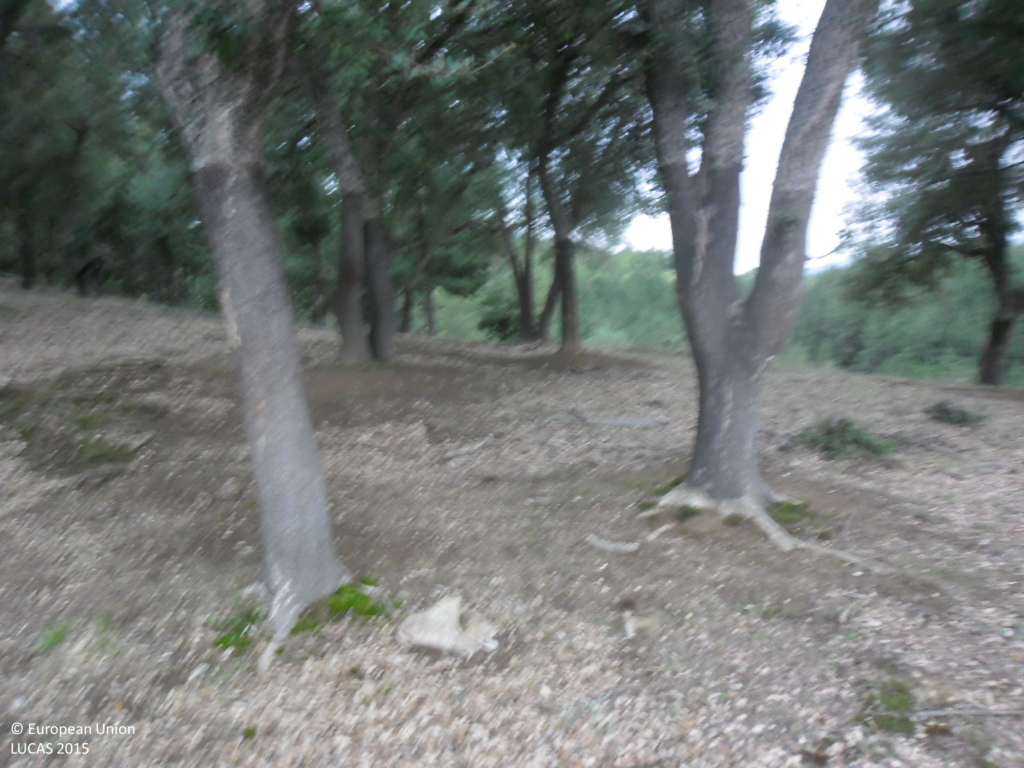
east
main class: Grassland
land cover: Grassland with sparse tree/shrub cover
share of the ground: > 75 %
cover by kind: herbaceous plants 90 %, broadleaved forest trees 5 %, shrubs 5 %
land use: Agriculture (excluding fallow land and kitchen gardens)
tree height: < 5 m
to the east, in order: Grassland with sparse tree/shrub cover; Broadleaved woodland; Ditches and canals; Broadleaved woodland; Pine dominated coniferous woodland; Broadleaved woodland; Grassland with sparse tree/shrub cover
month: September
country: BG
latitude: 41.4223
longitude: 23.0474
